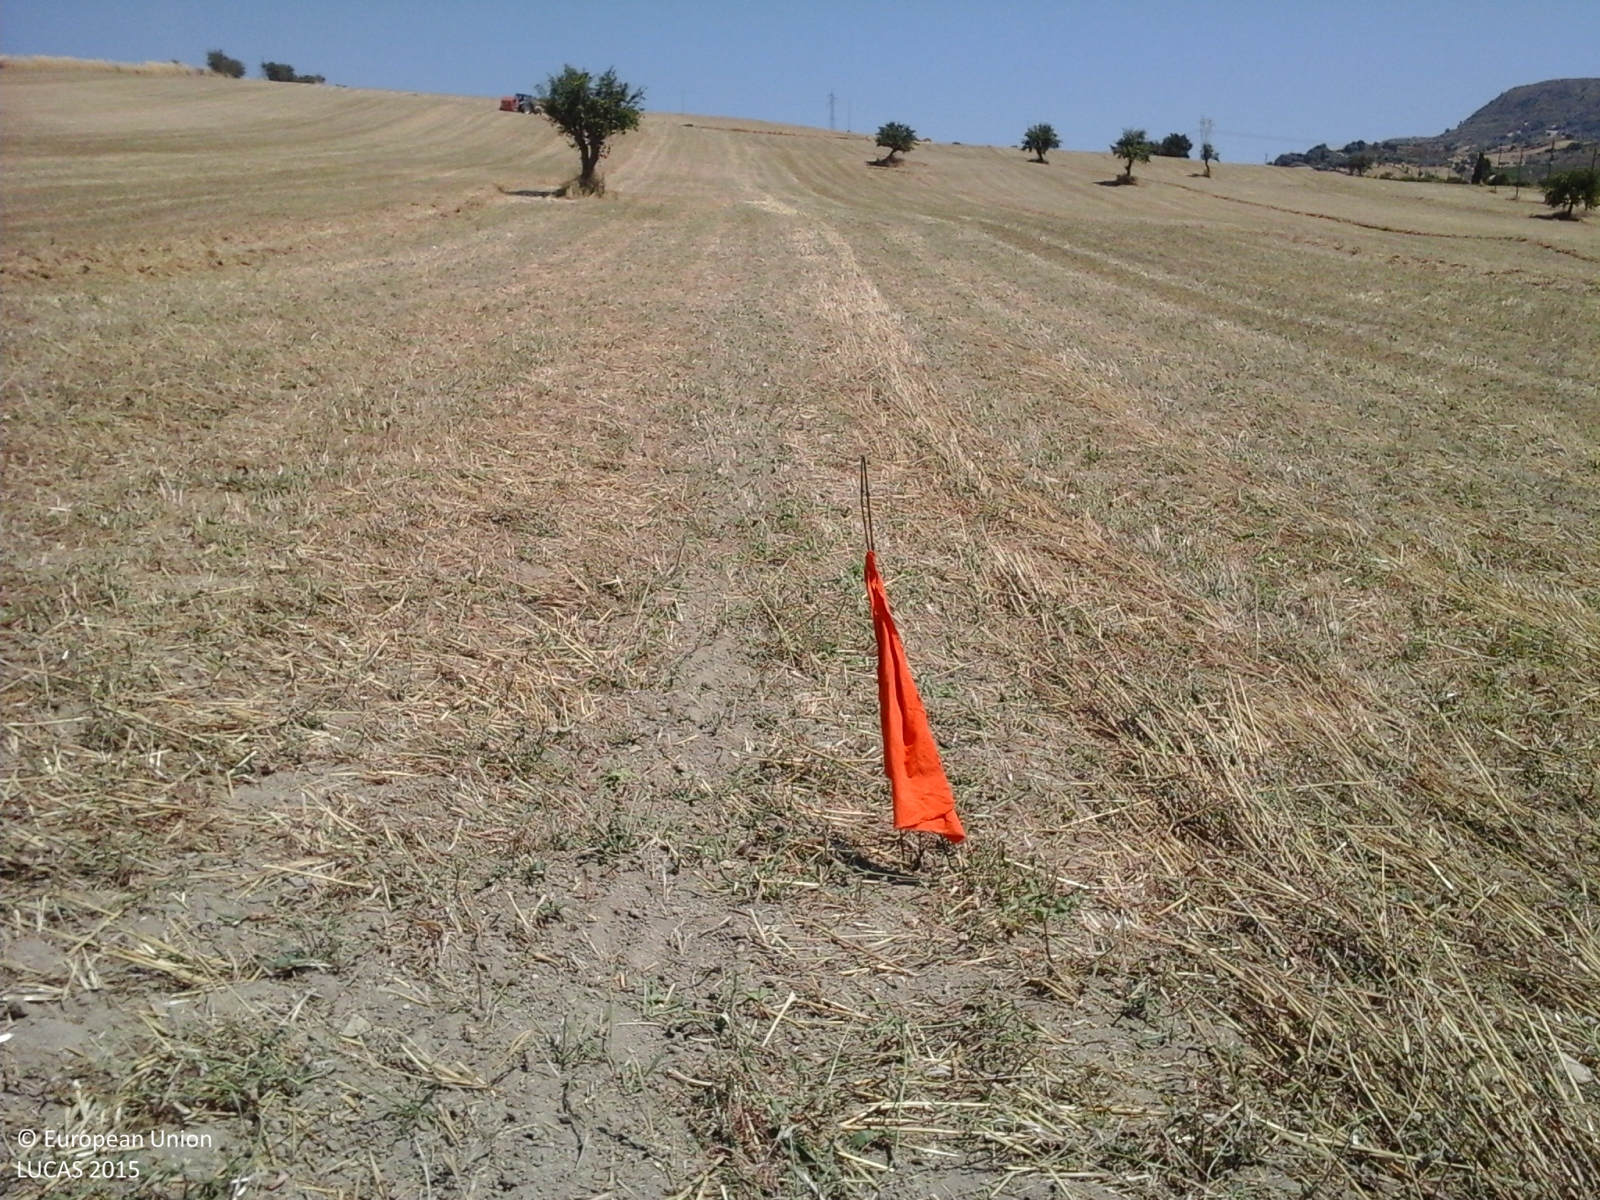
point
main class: Cropland
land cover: Durum wheat
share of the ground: > 75 %
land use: Agriculture (excluding fallow land and kitchen gardens)
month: July
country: IT
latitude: 37.0223
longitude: 14.8741
